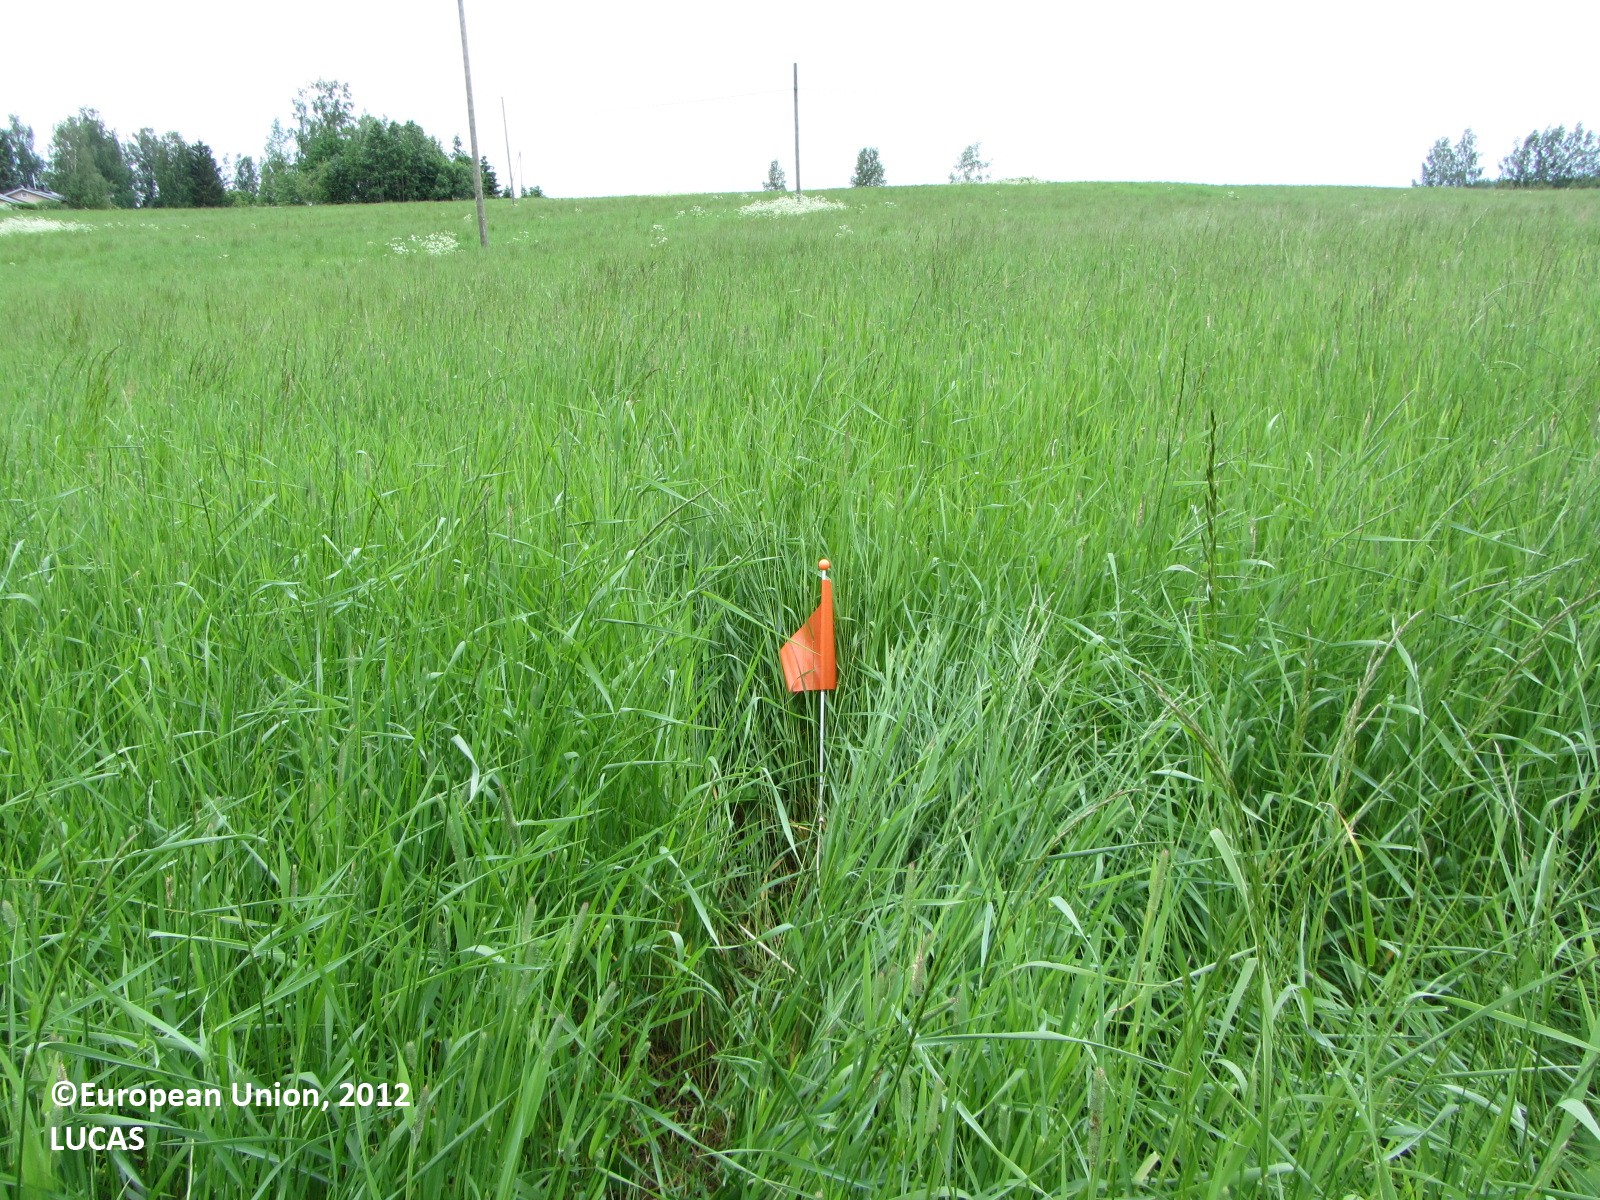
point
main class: Cropland
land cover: Temporary grasslands
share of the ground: > 75 %
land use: Agriculture (excluding fallow land and kitchen gardens)
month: June
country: FI
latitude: 62.6972
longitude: 25.0488
